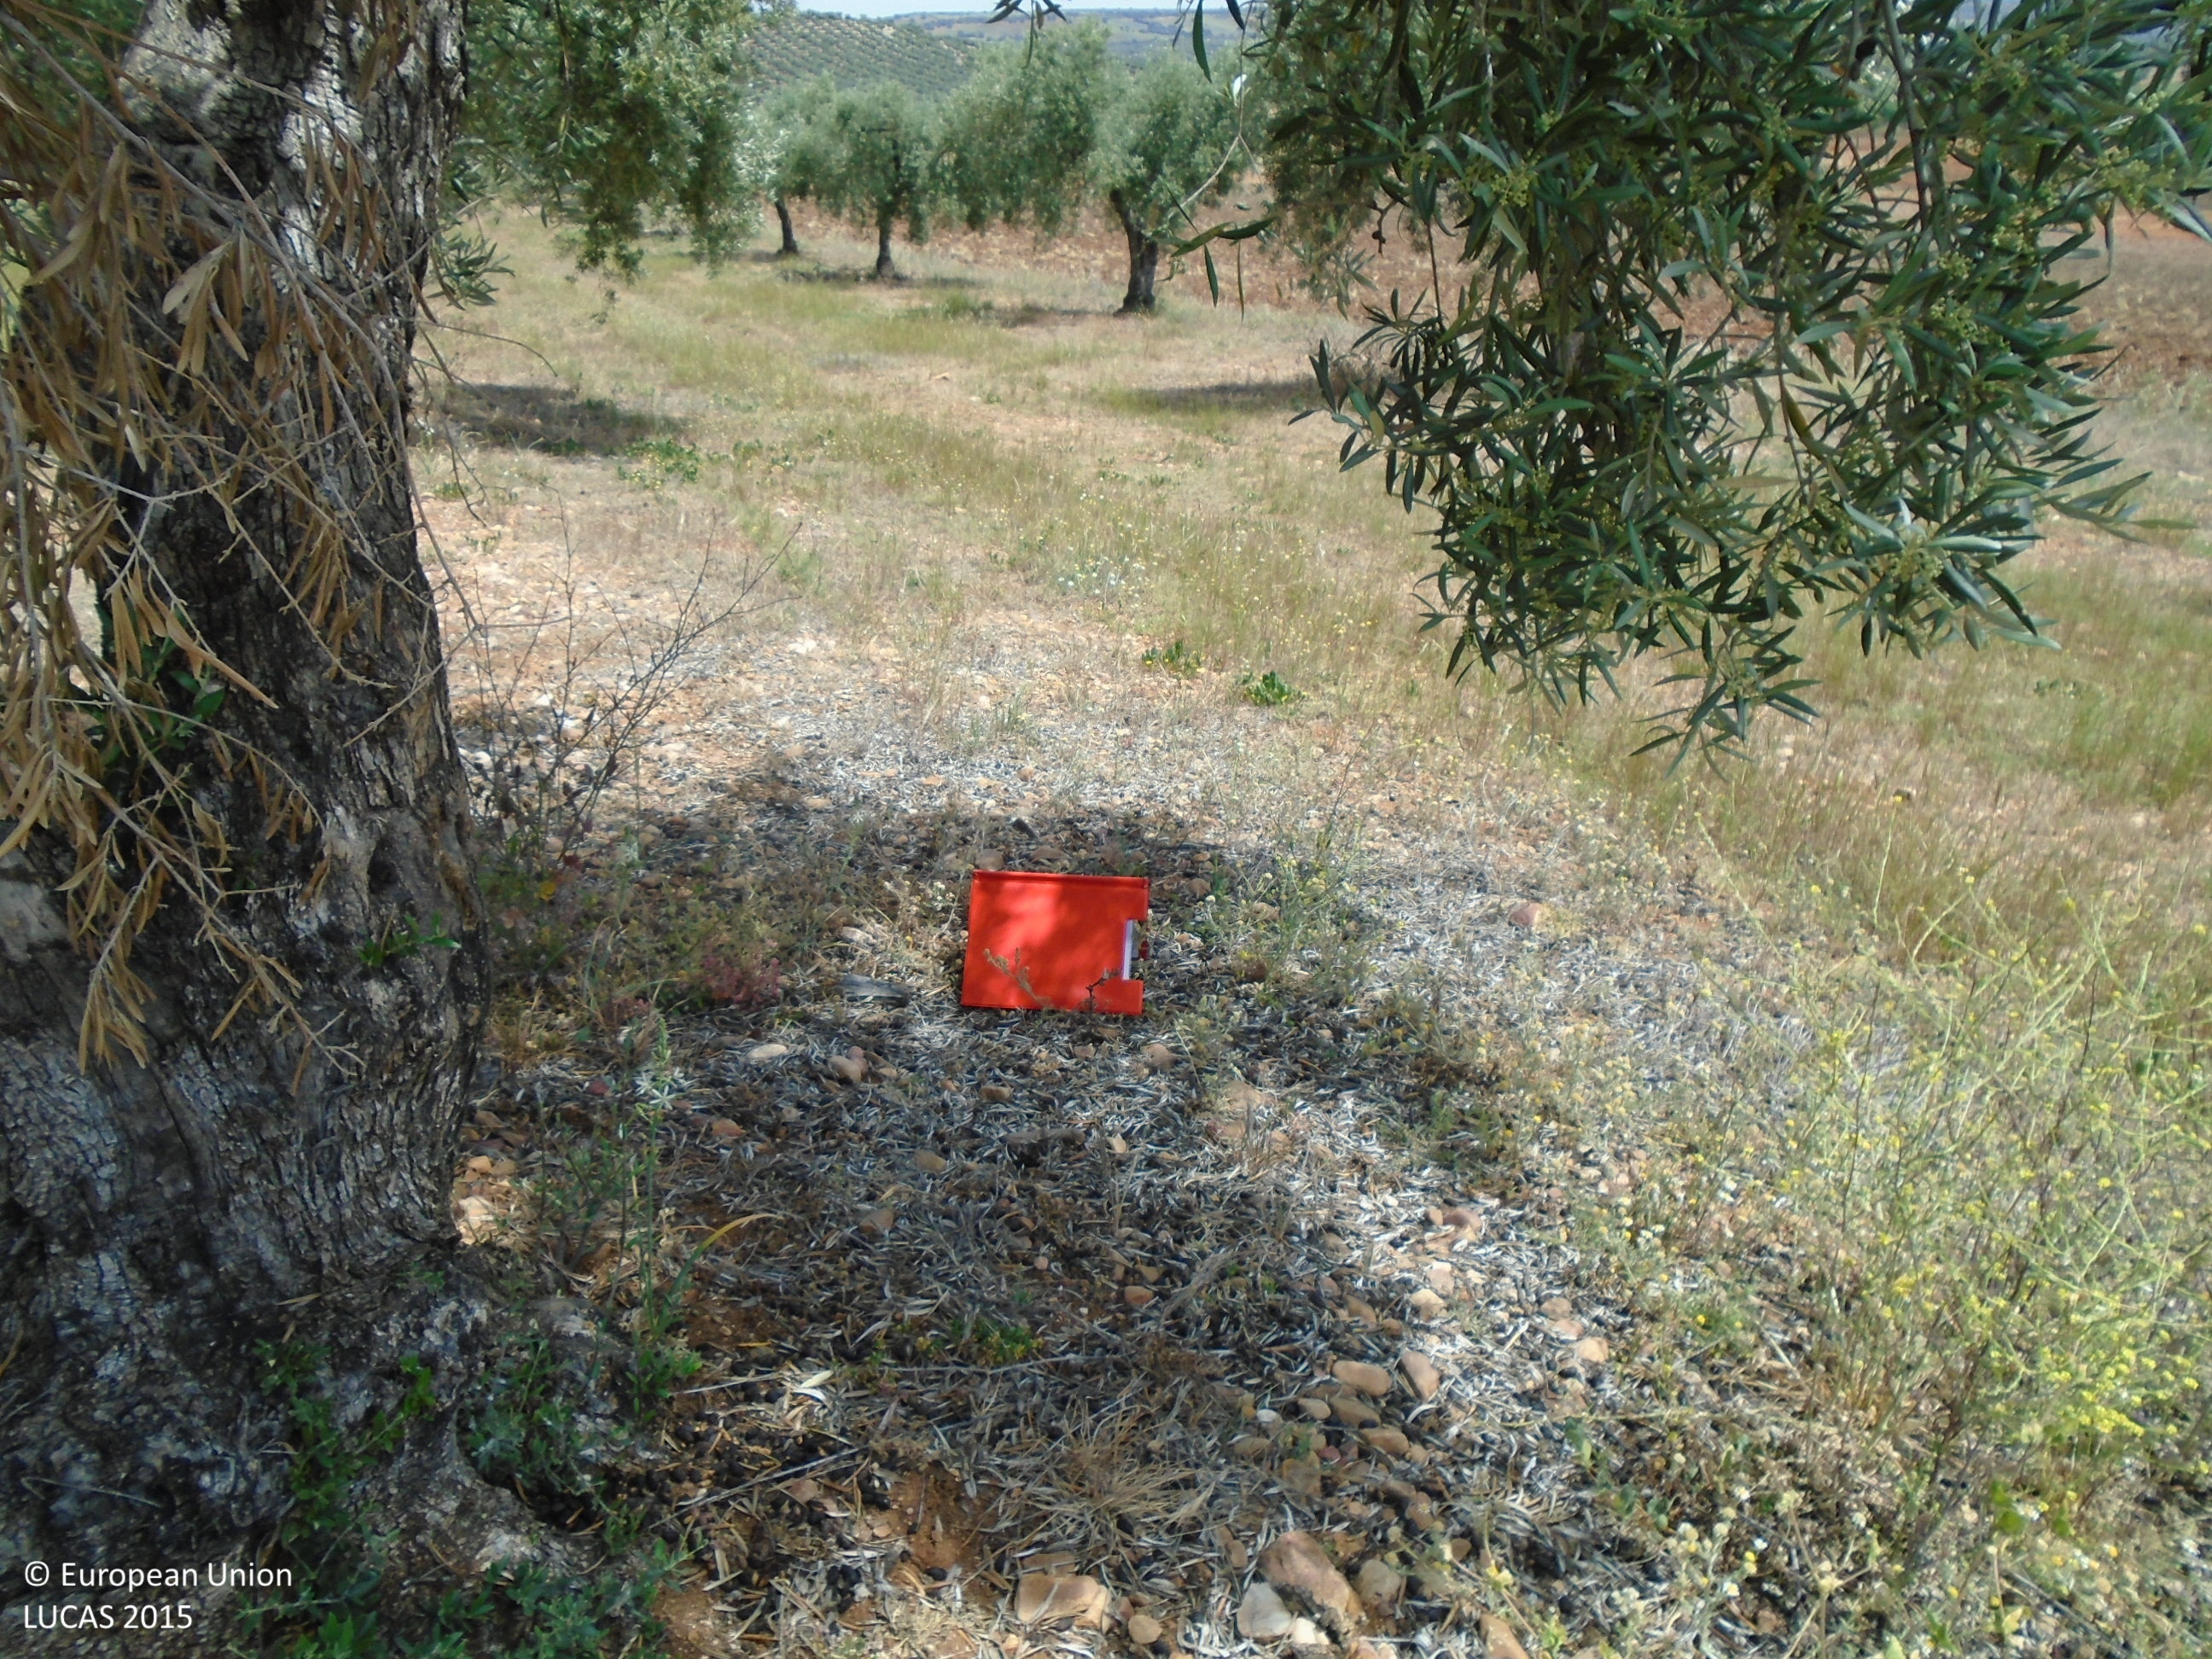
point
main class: Cropland
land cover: Olive groves
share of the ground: 10 - 25 %
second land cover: Spontaneously vegetated surfaces
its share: > 75 %
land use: Agriculture (excluding fallow land and kitchen gardens)
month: May
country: ES
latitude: 39.7496
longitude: -4.6418
